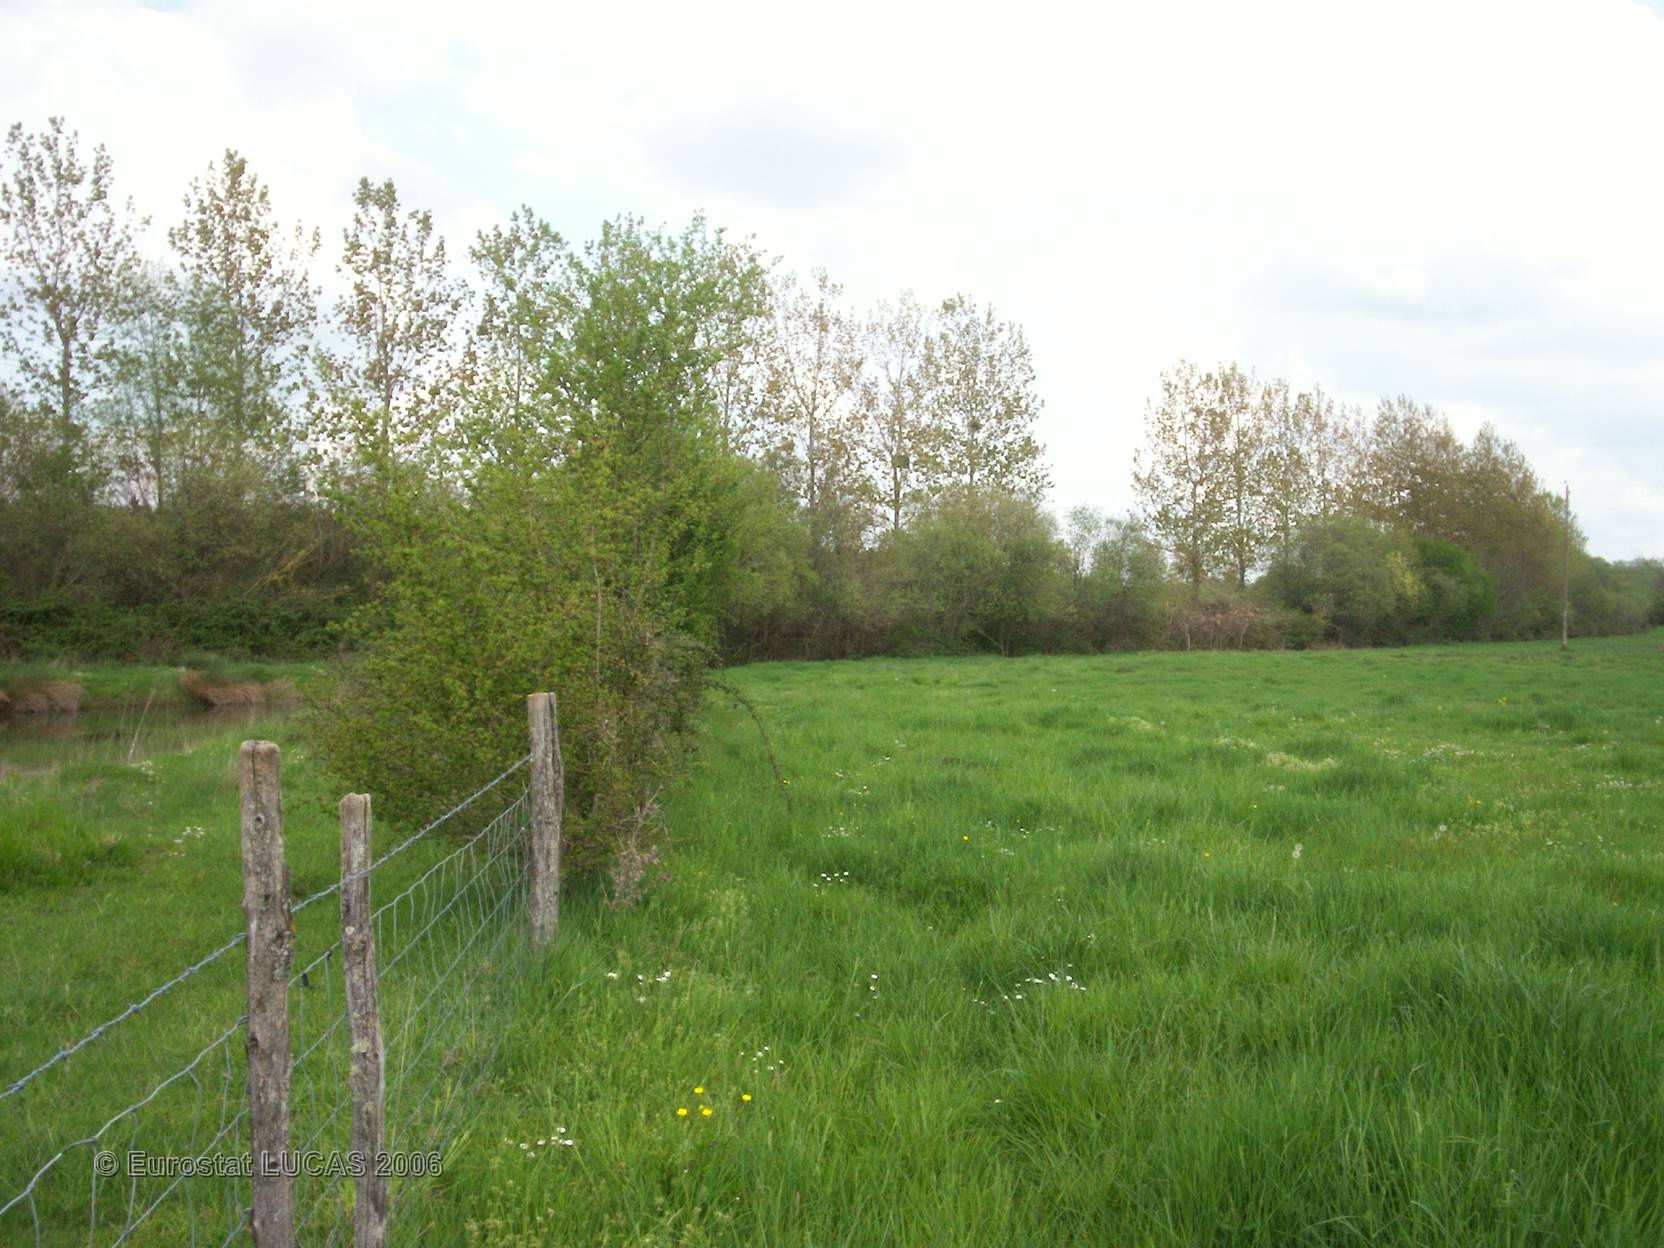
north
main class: Grassland
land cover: Grassland with sparse tree/shrub cover
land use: Agriculture (excluding fallow land and kitchen gardens)
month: April
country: FR
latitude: 46.3633
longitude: 0.5079
